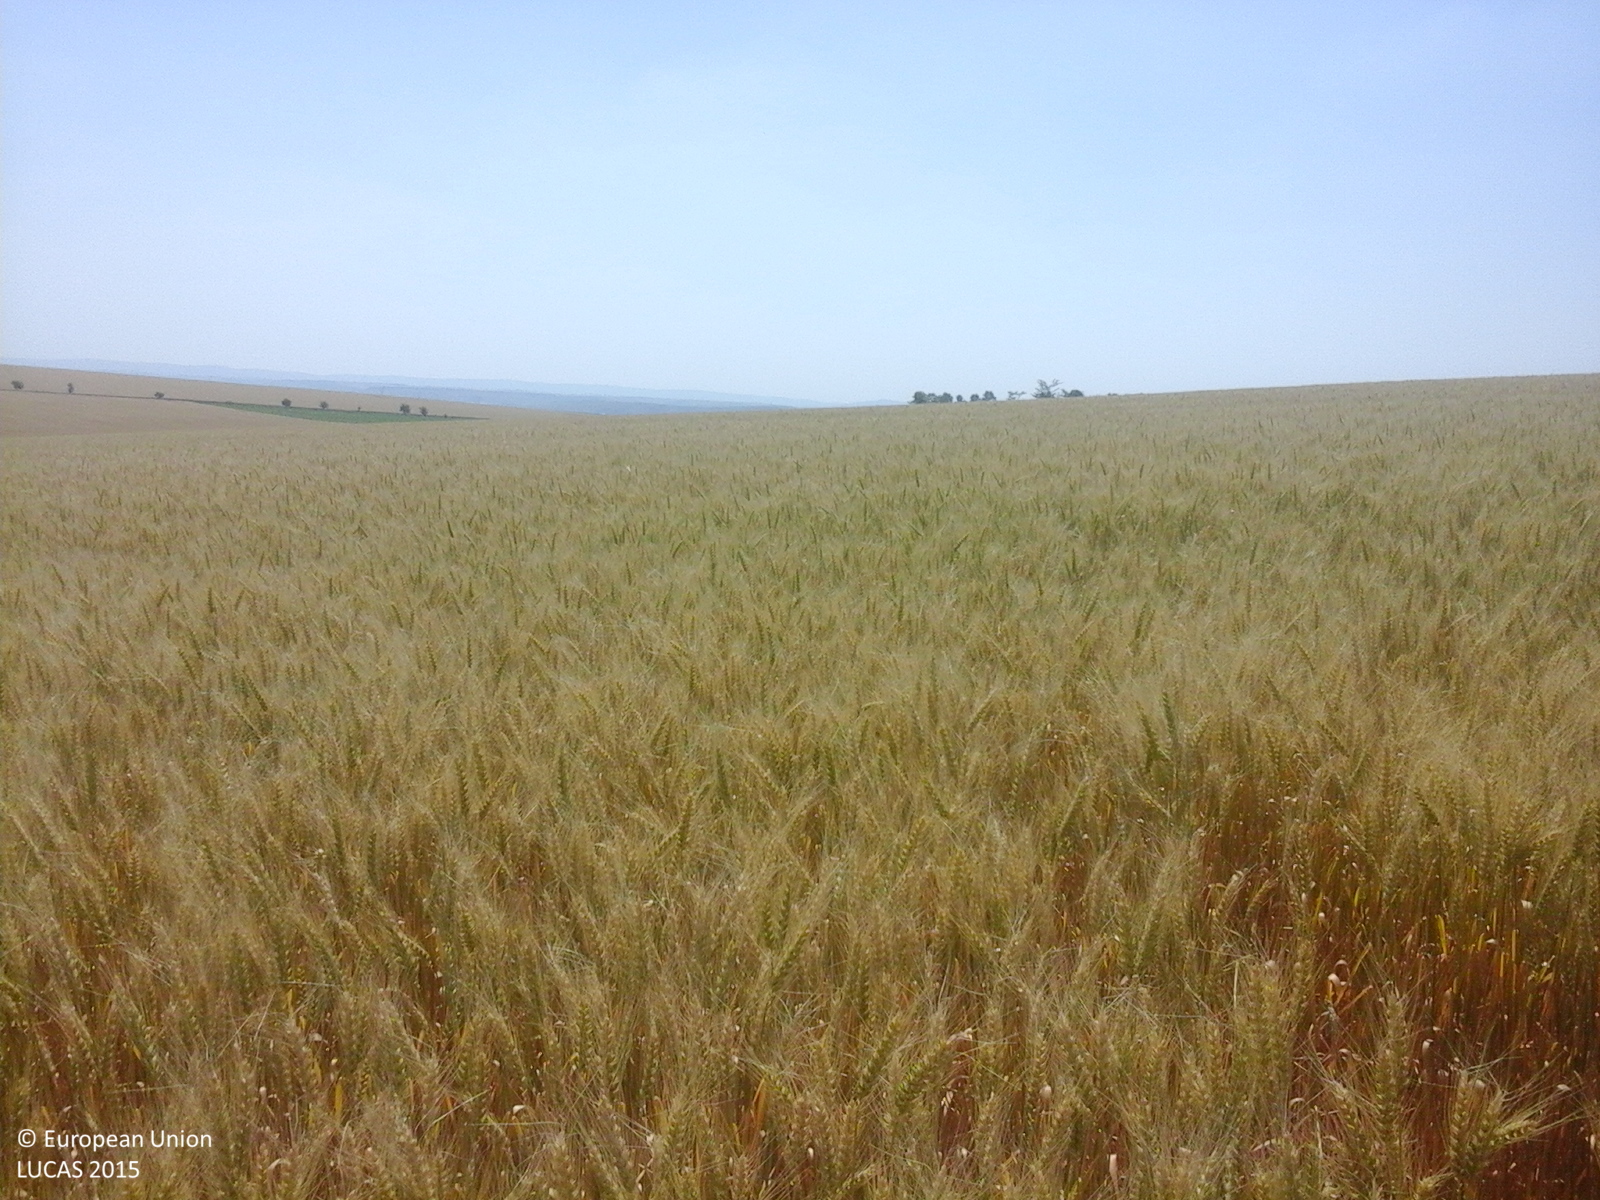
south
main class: Cropland
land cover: Common wheat
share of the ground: > 75 %
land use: Agriculture (excluding fallow land and kitchen gardens)
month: June
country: RO
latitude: 47.2467
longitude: 27.2990
